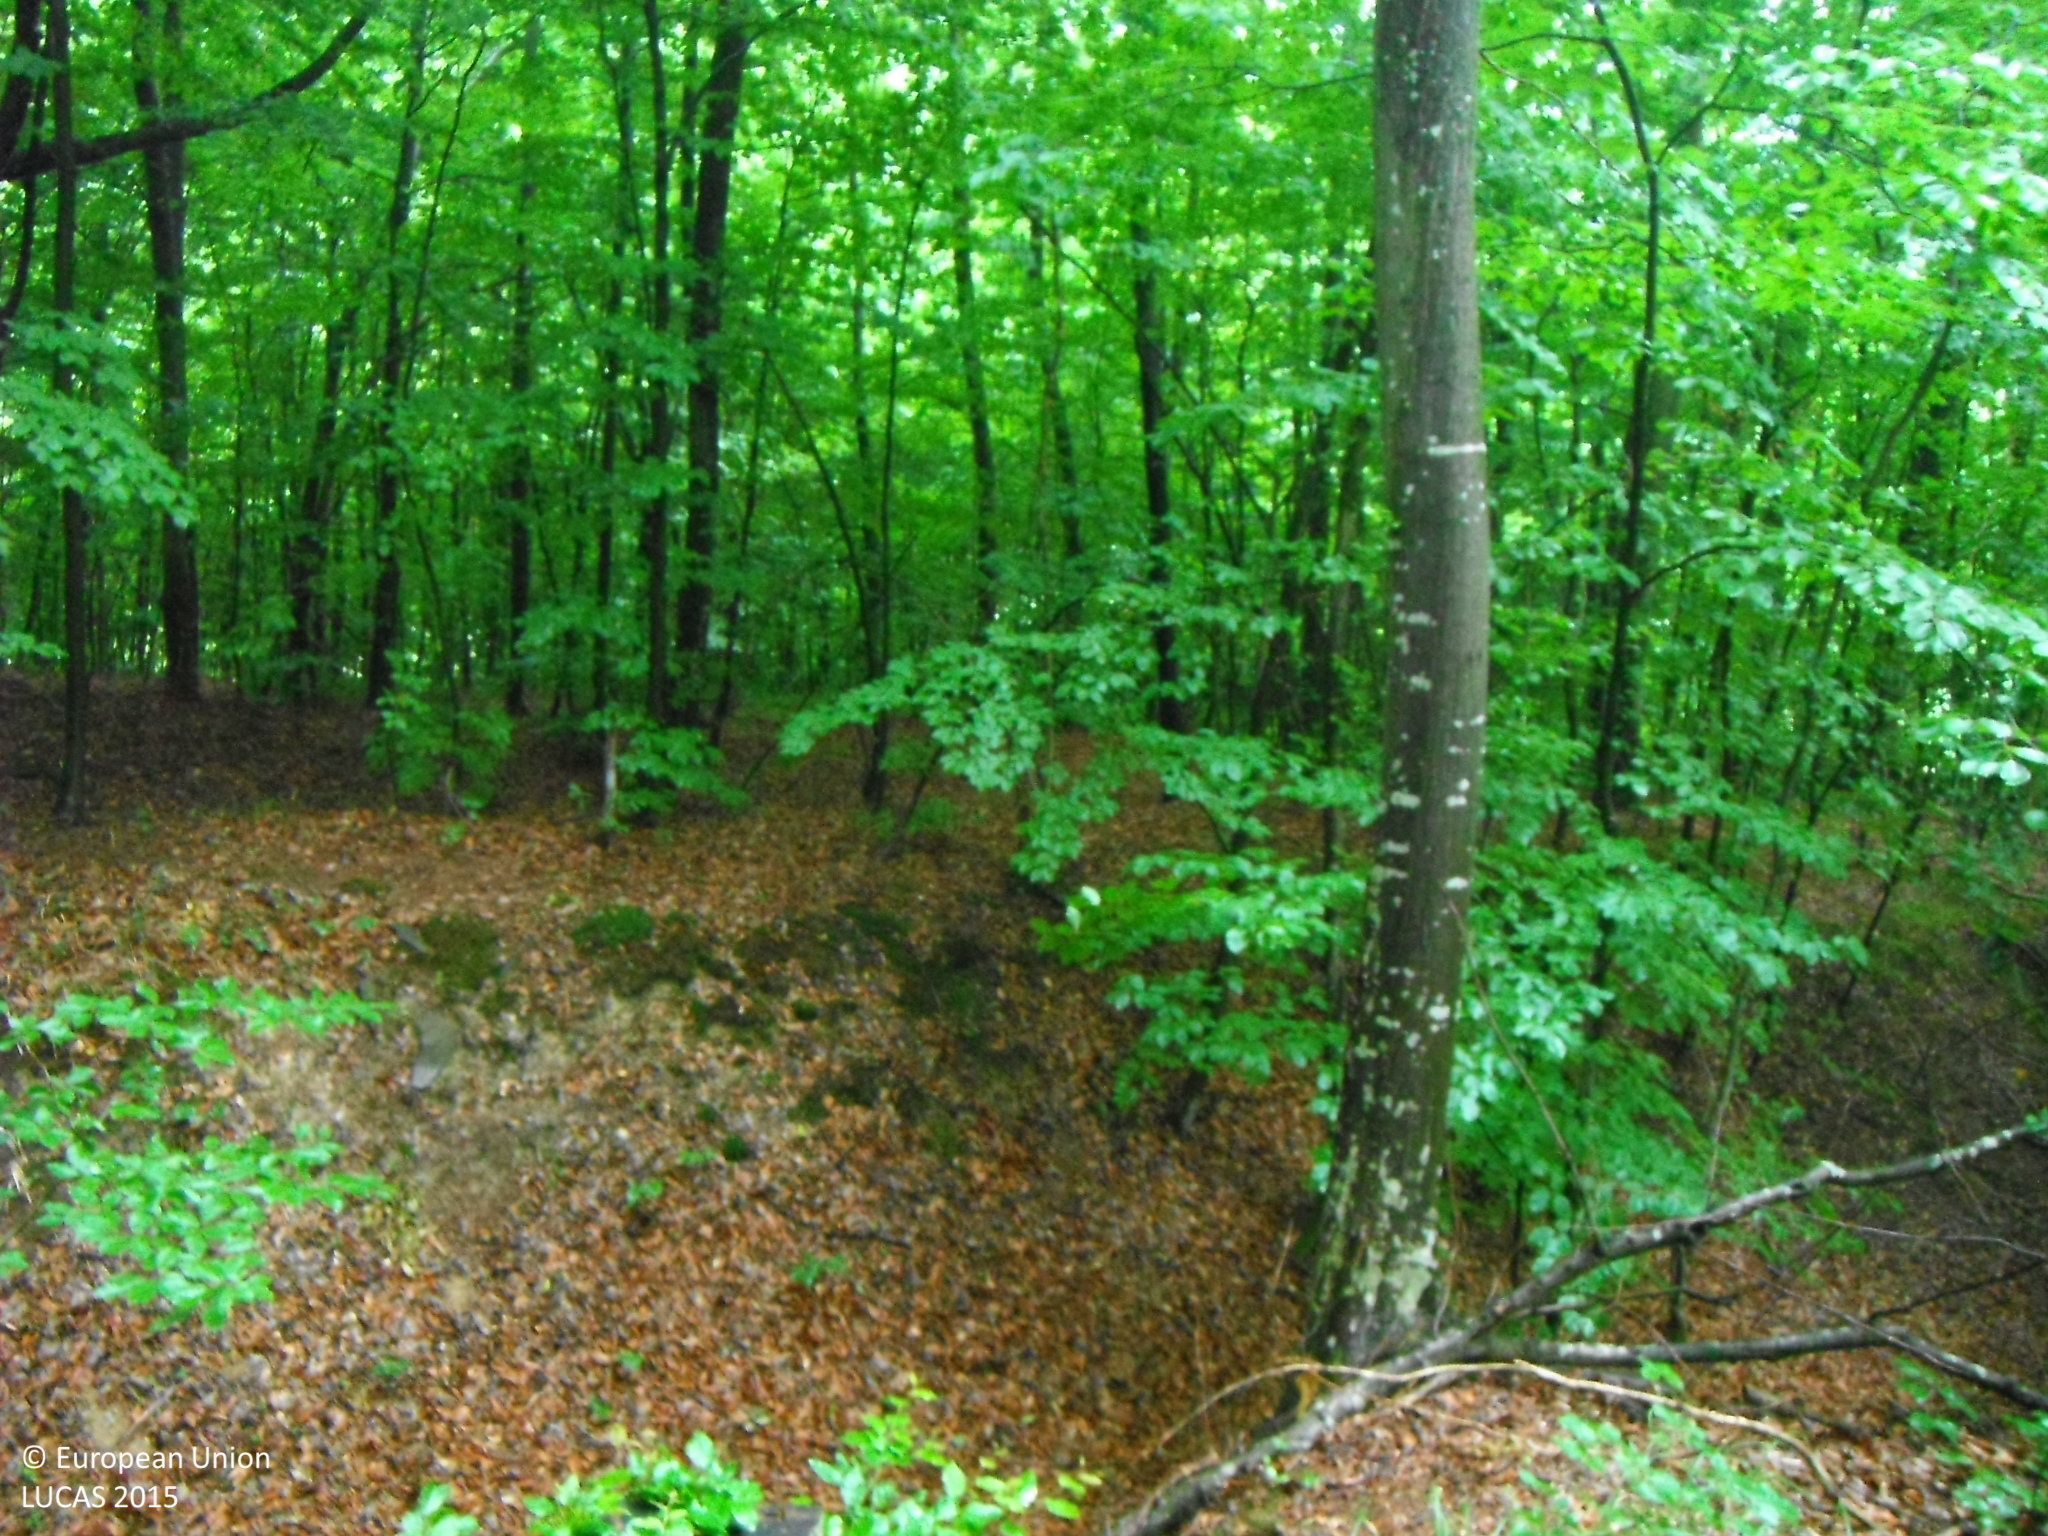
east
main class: Woodland
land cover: Broadleaved woodland
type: beech forest
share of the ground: > 75 %
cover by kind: broadleaved forest trees 100 %
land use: Forestry
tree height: > 5 m
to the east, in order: Broadleaved woodland; Tracks; Broadleaved woodland
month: June
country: SK
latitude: 49.1244
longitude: 22.0467
